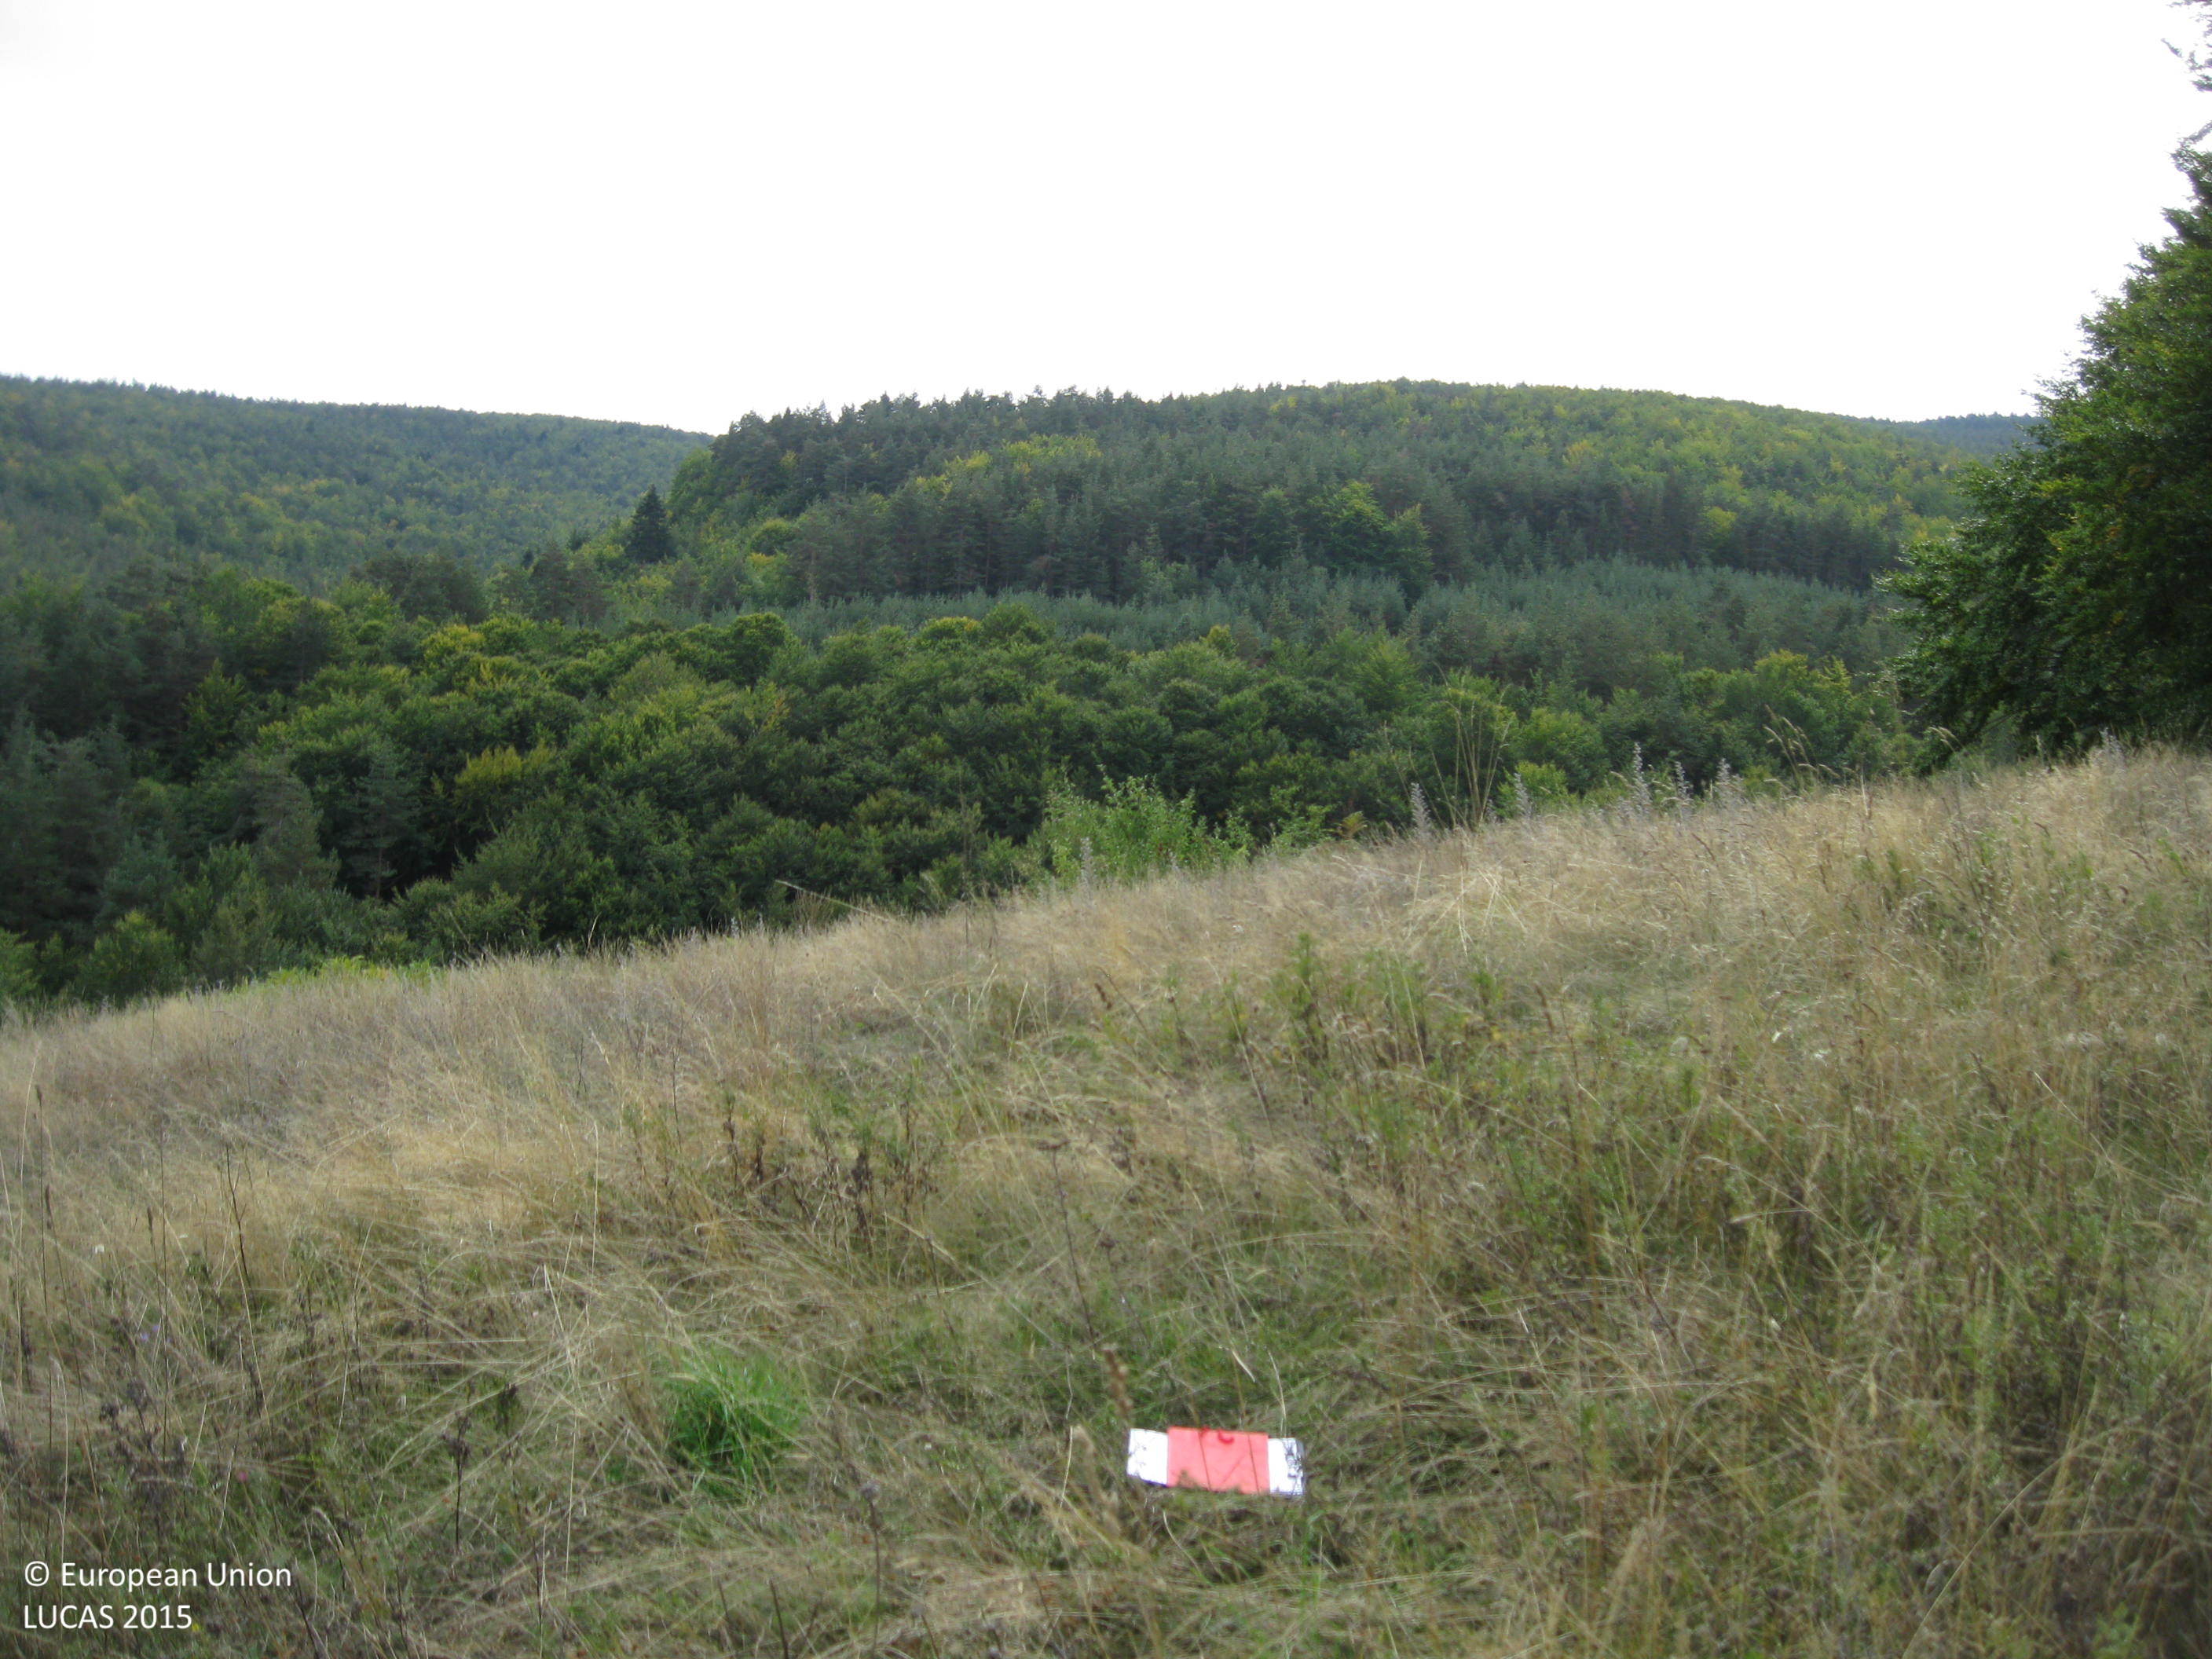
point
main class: Grassland
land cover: Grassland without tree/shrub cover
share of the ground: > 75 %
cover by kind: herbaceous plants 100 %
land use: Agriculture (excluding fallow land and kitchen gardens)
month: October
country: BG
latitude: 42.0007
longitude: 24.5457
